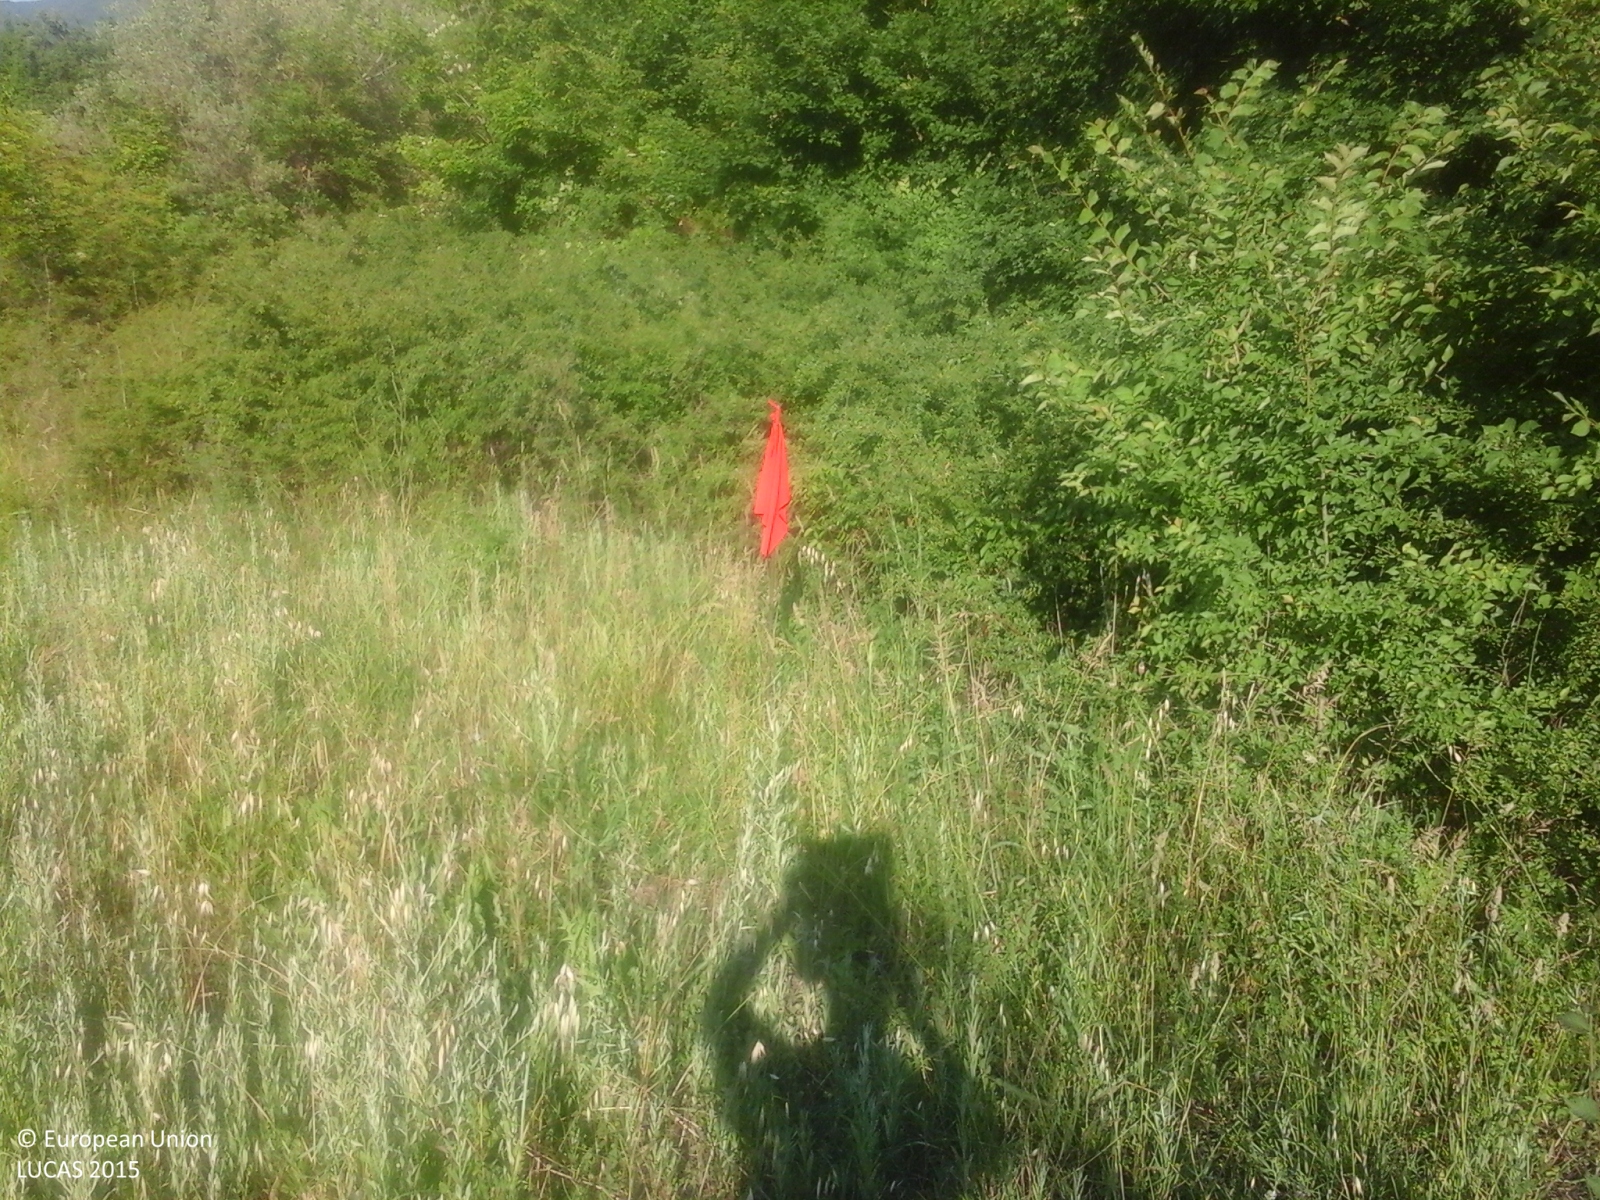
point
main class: Grassland
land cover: Grassland without tree/shrub cover
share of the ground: 25 - 50 %
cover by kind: herbaceous plants 95 %, shrubs 5 %
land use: Abandoned areas
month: June
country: IT
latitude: 42.0362
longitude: 14.3468
